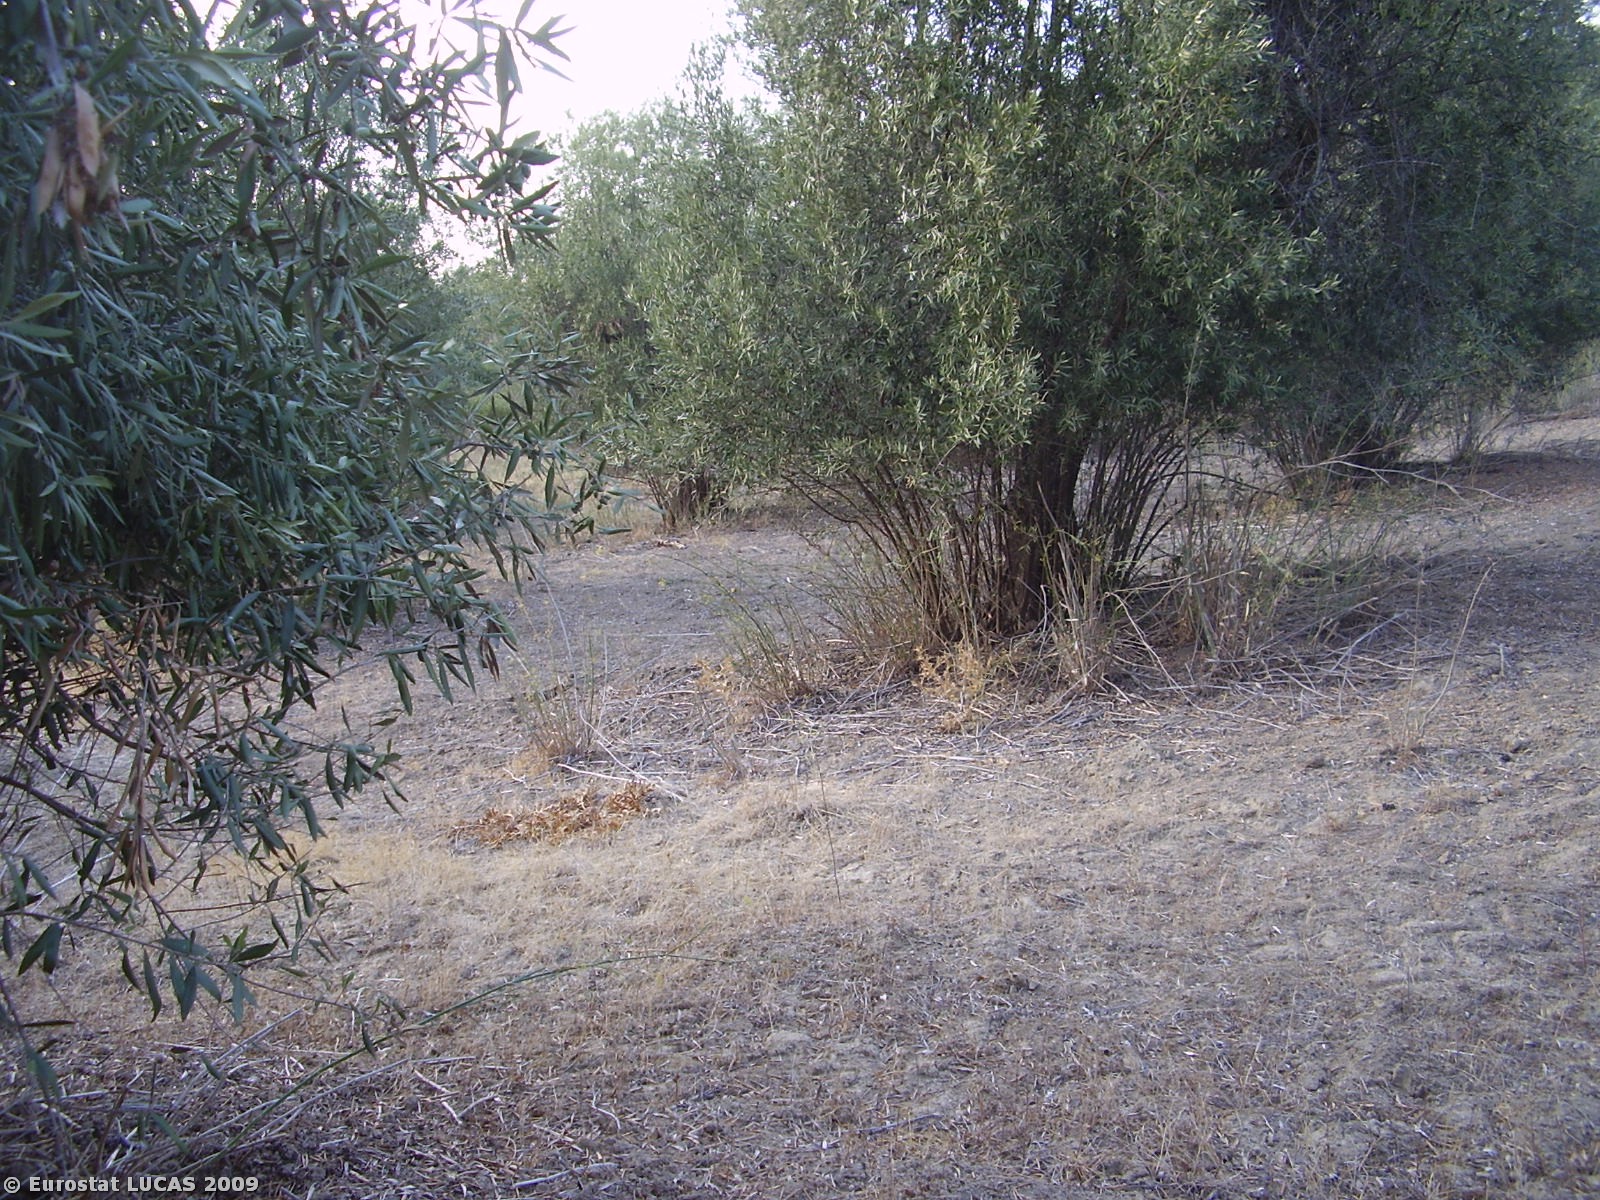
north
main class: Cropland
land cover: Olive groves
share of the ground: 10 - 25 %
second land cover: Spontaneously vegetated surfaces
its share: 50 - 75 %
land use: Agriculture (excluding fallow land and kitchen gardens)
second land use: Fallow land
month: August
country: PT
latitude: 38.2345
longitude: -8.0061
